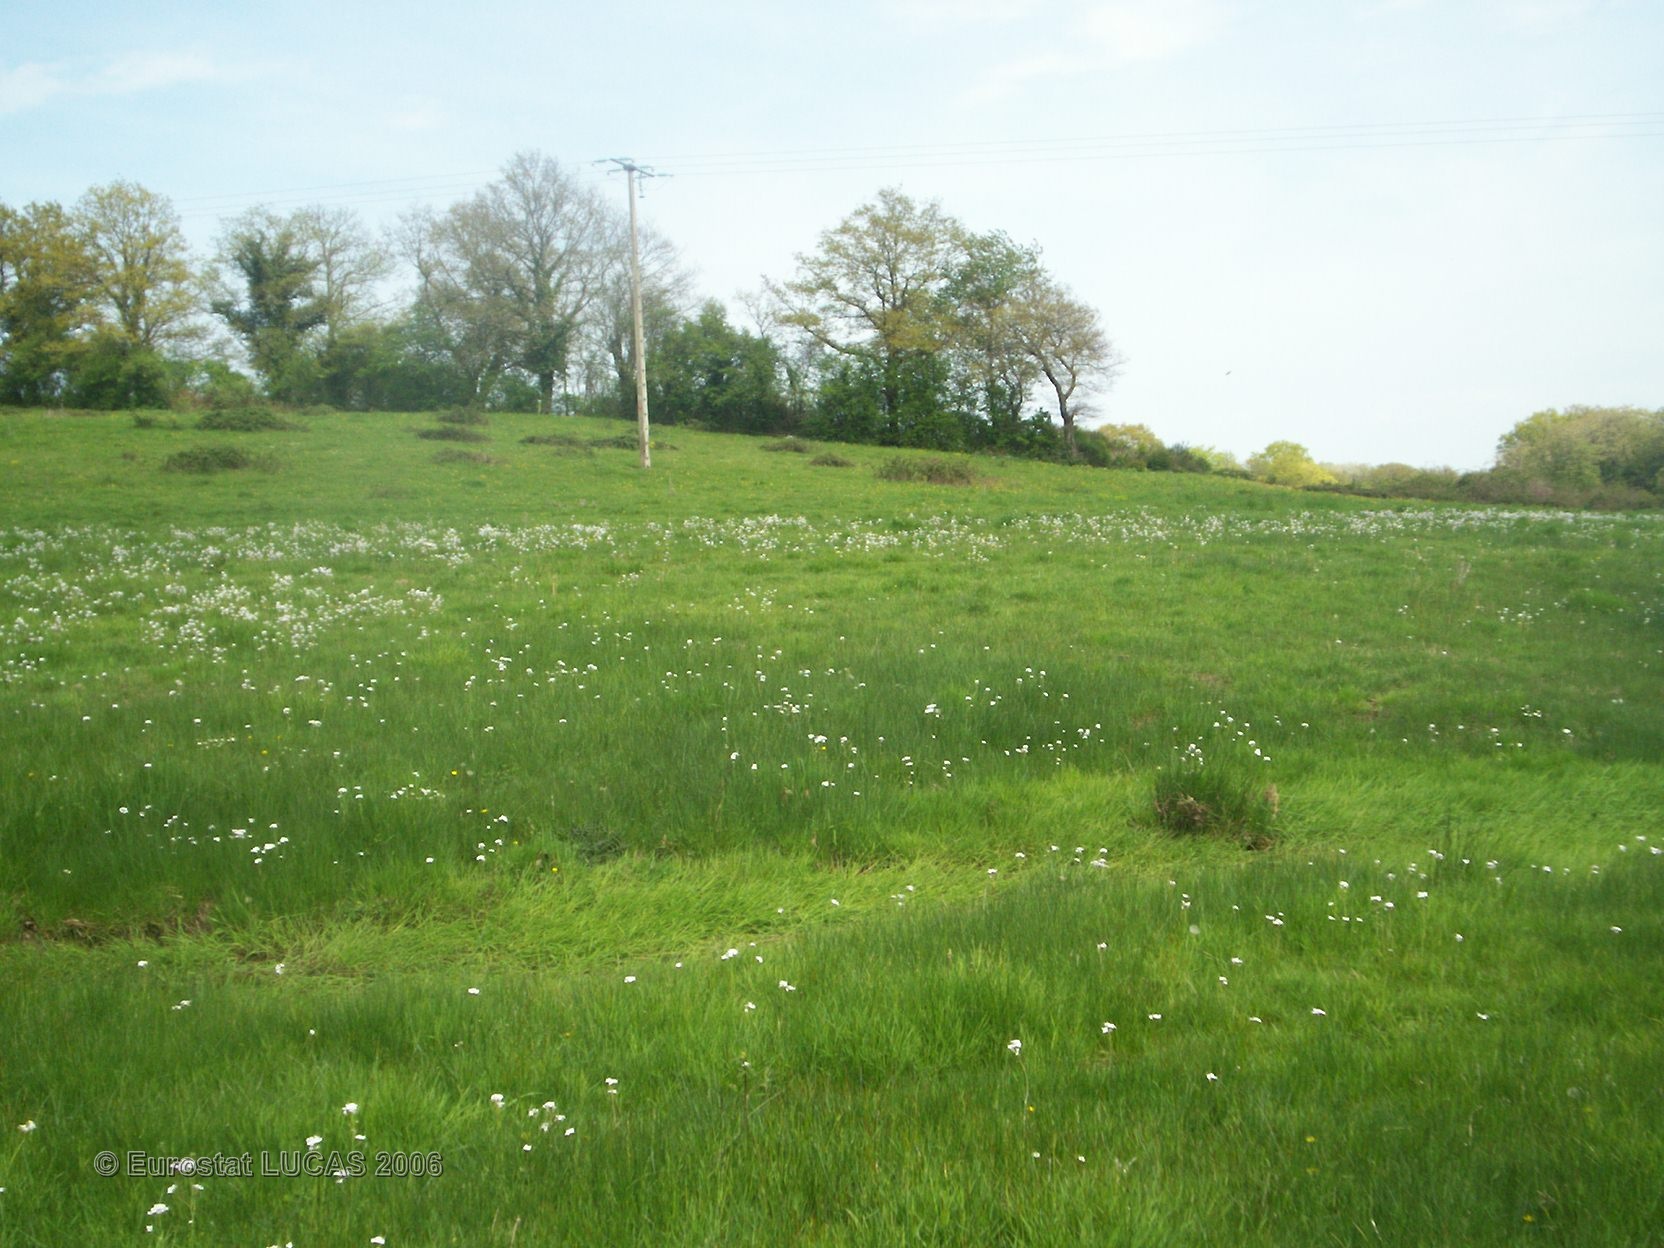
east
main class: Grassland
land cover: Grassland without tree/shrub cover
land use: Agriculture (excluding fallow land and kitchen gardens)
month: May
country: FR
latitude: 46.4022
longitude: 3.1433
